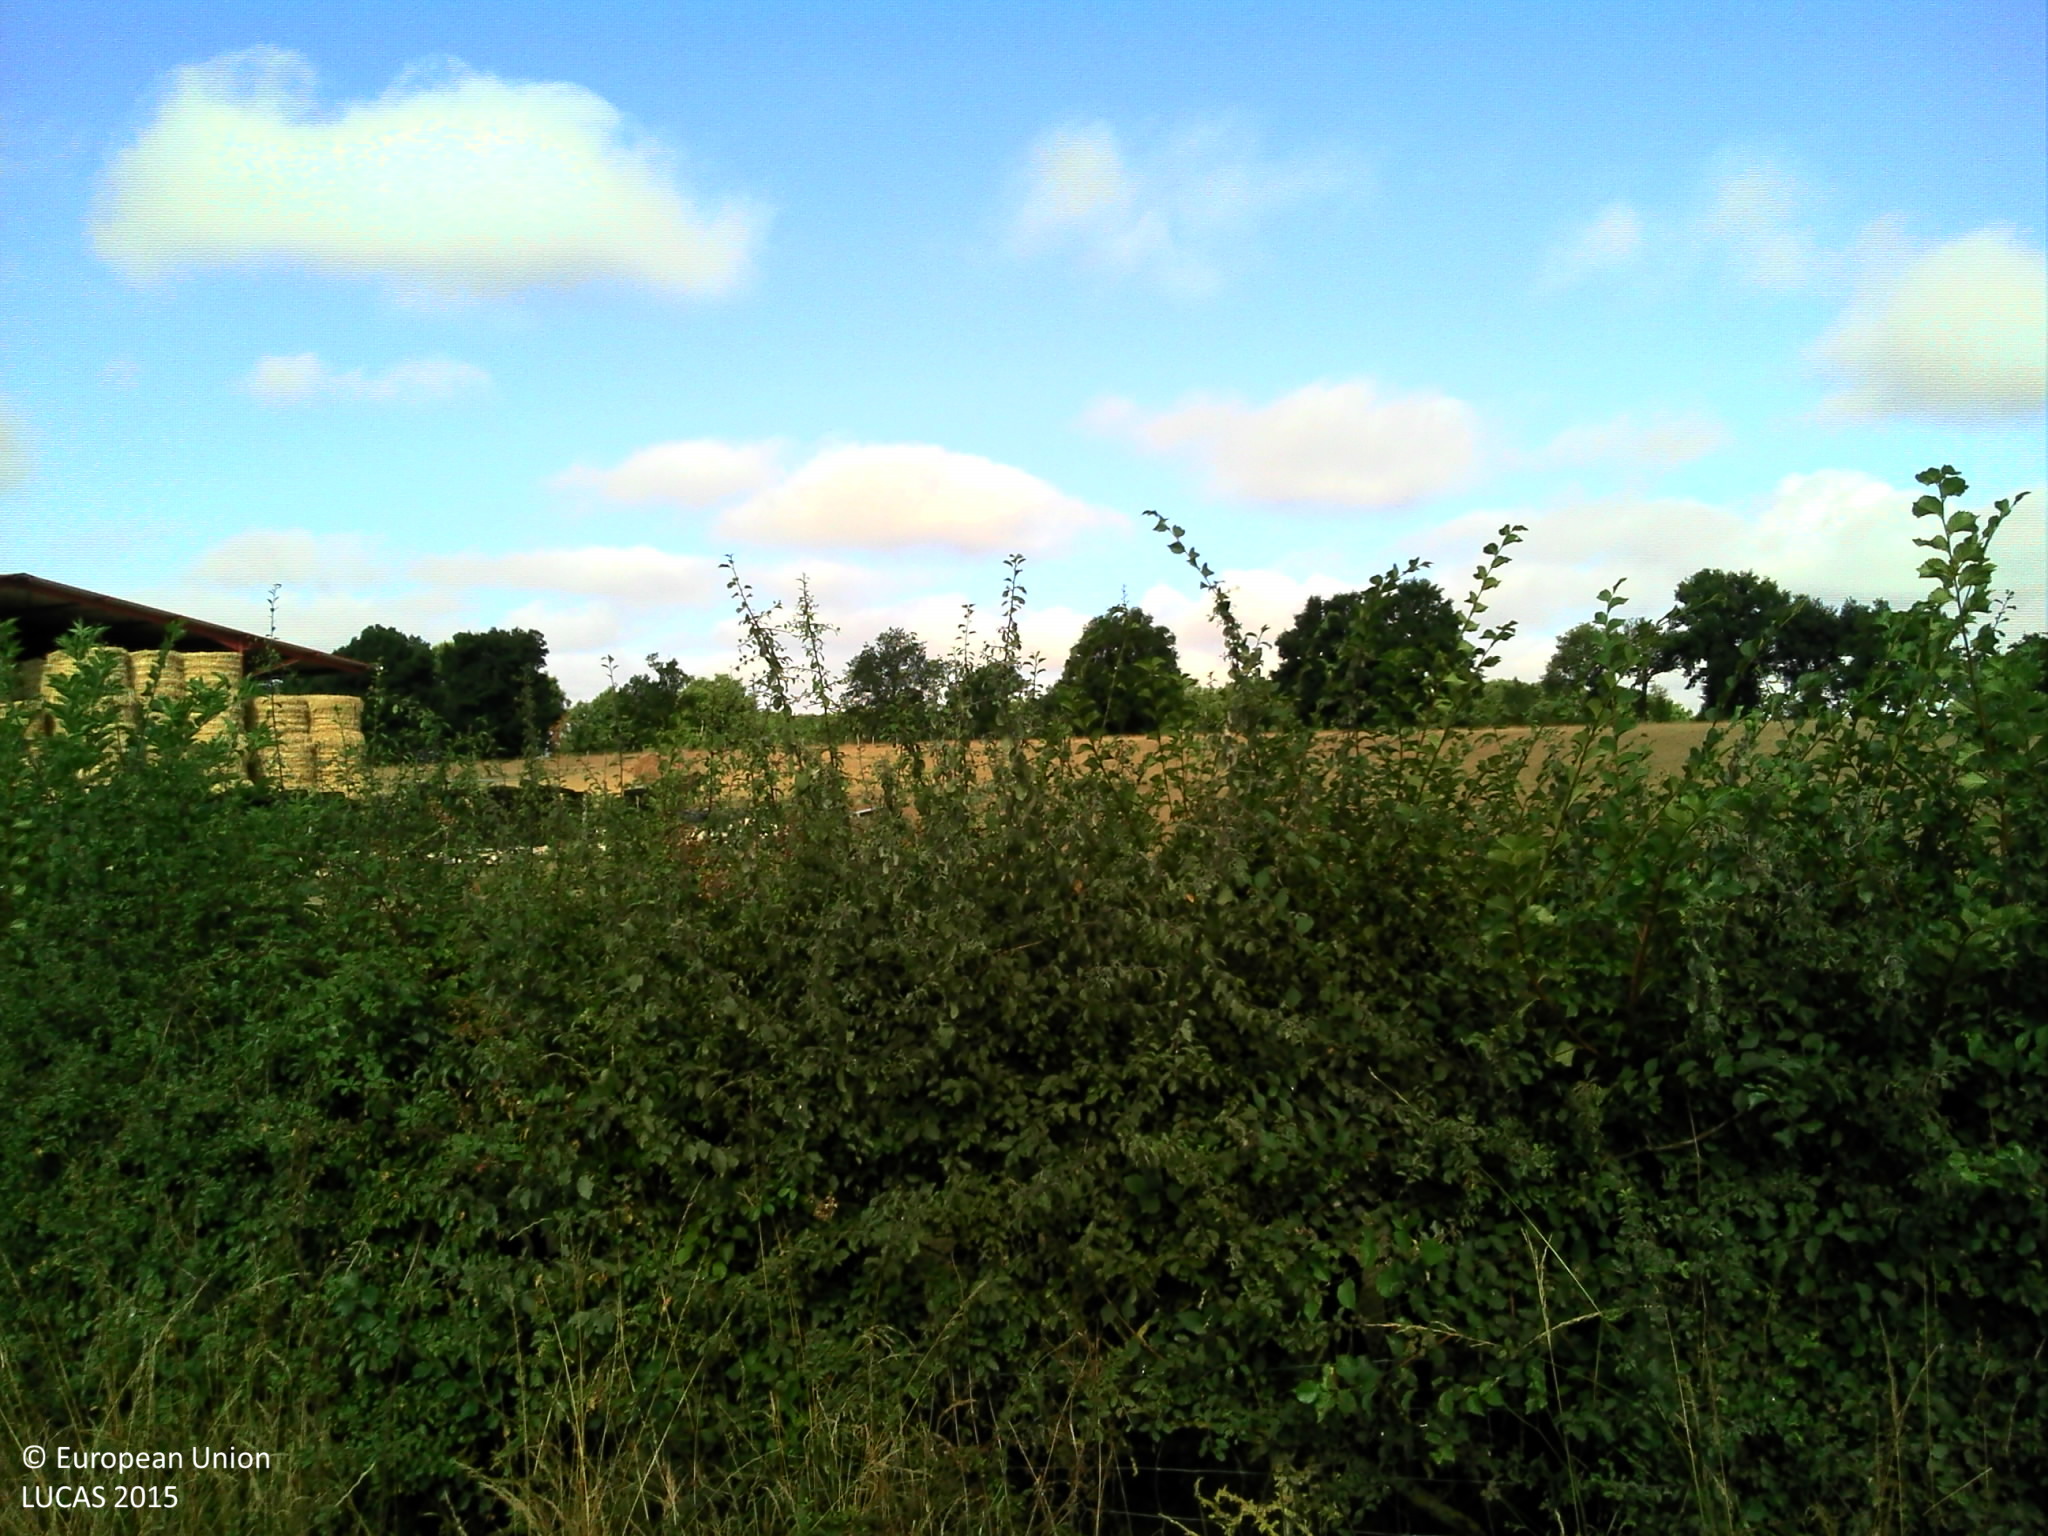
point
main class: Grassland
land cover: Grassland without tree/shrub cover
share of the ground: > 75 %
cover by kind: herbaceous plants 100 %
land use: Agriculture (excluding fallow land and kitchen gardens)
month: July
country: FR
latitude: 46.2183
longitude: 0.5075
